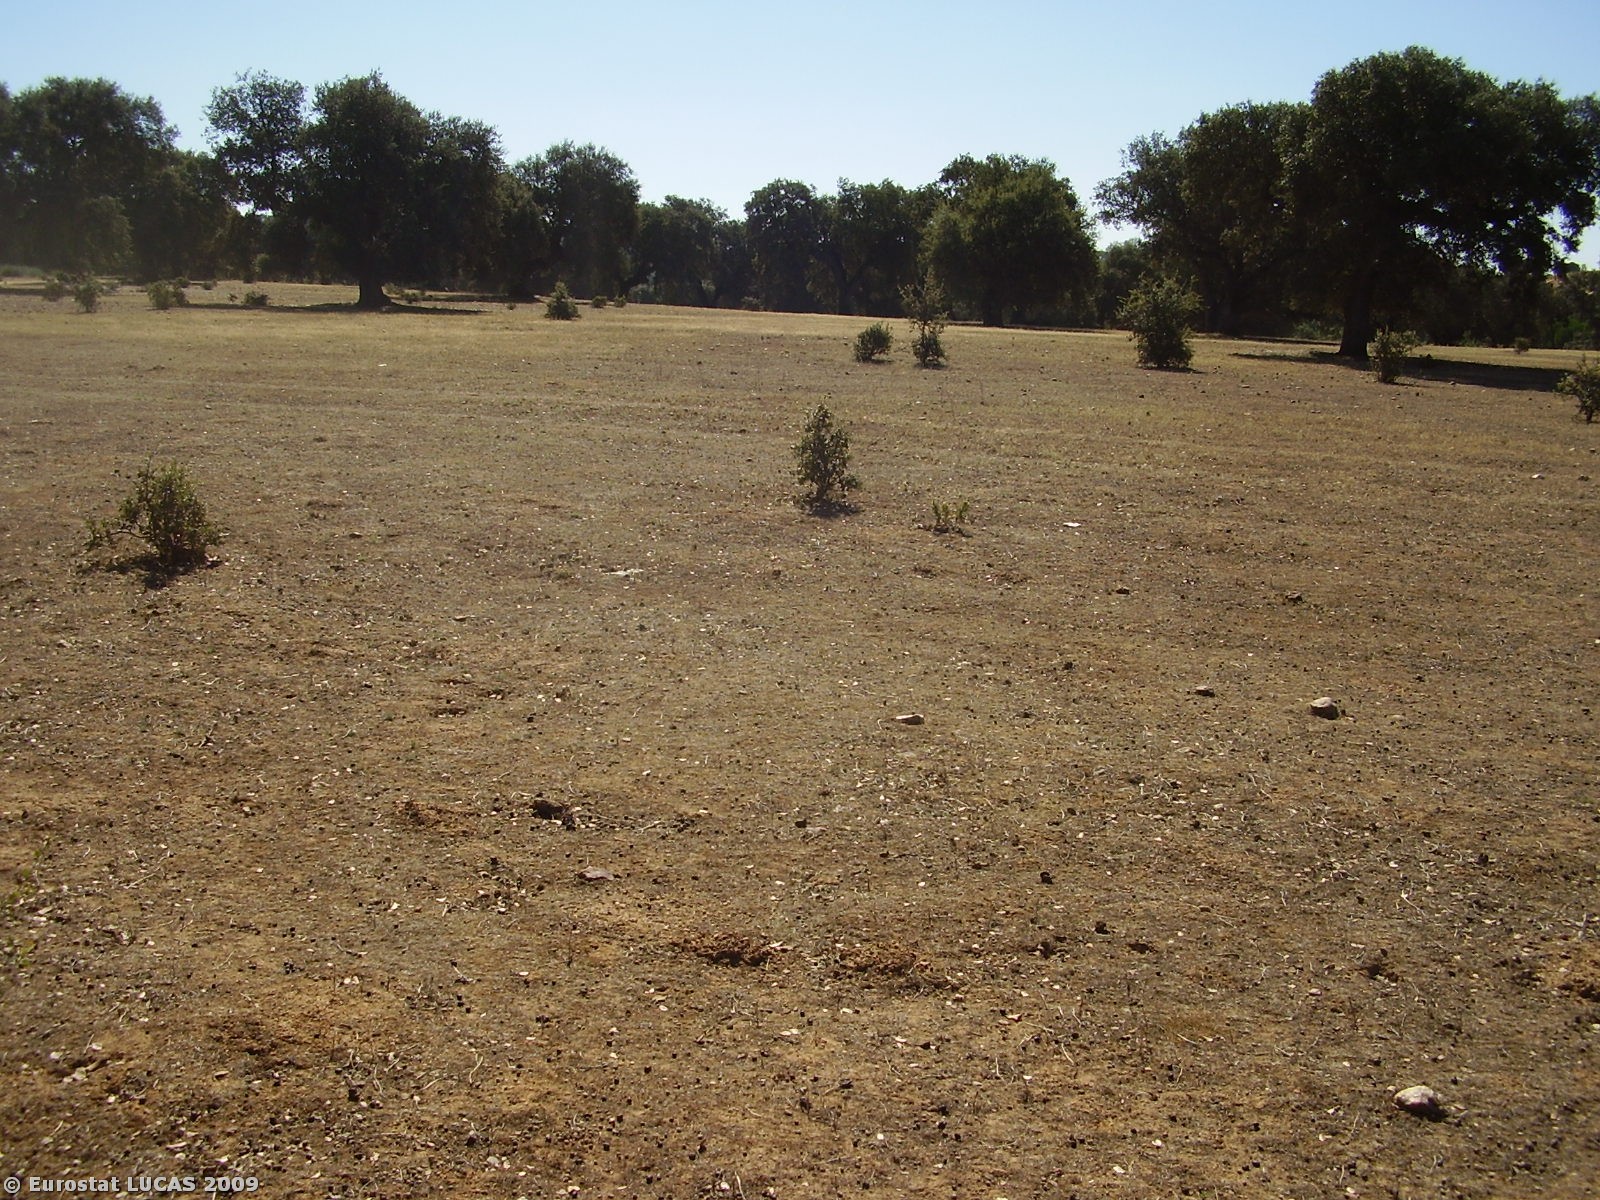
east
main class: Woodland
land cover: Broadleaved woodland
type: broadleaved evergreen forest
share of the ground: 10 - 25 %
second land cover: Bare land
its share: 50 - 75 %
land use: Forestry
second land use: Fallow land
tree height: > 5 m
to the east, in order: Broadleaved woodland; Bare land; Broadleaved woodland; Fences; Paved roads, cycling and walking lanes; Broadleaved woodland
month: July
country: PT
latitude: 38.8779
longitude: -7.8294
